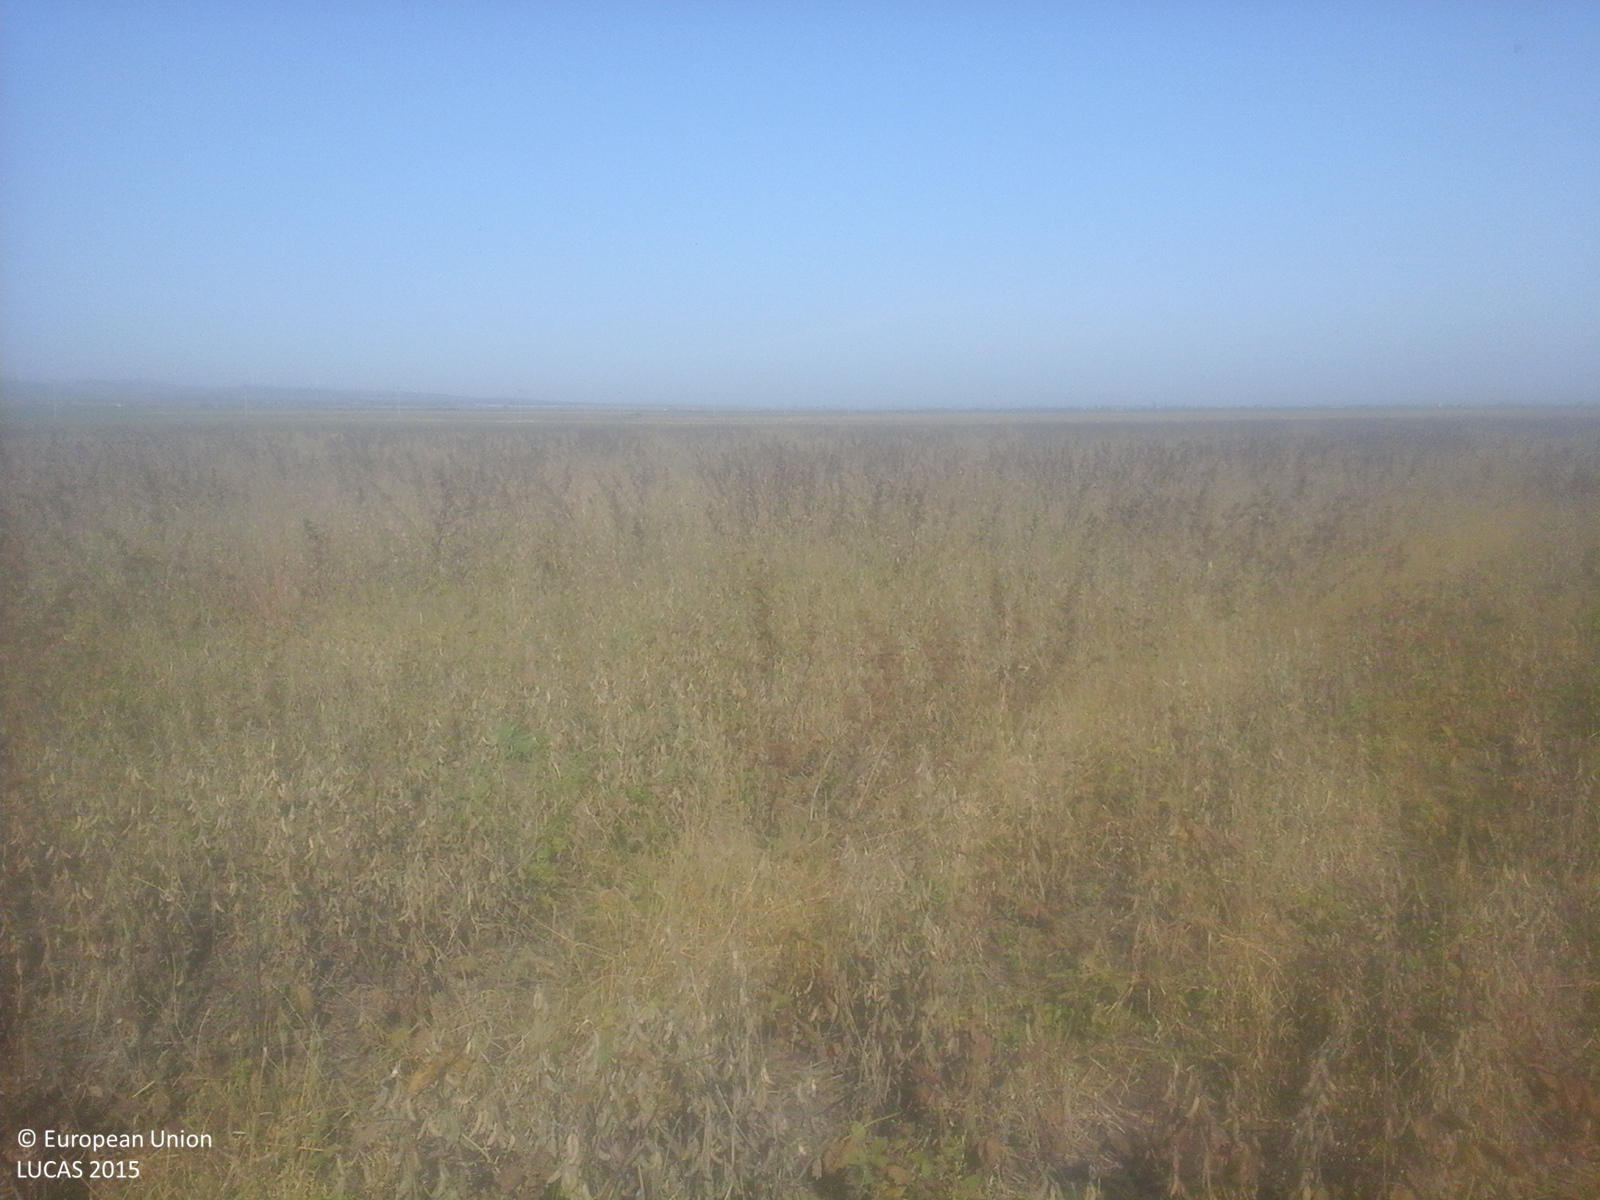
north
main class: Cropland
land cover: Soya
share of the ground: > 75 %
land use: Agriculture (excluding fallow land and kitchen gardens)
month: October
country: RO
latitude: 45.3283
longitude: 26.9917
